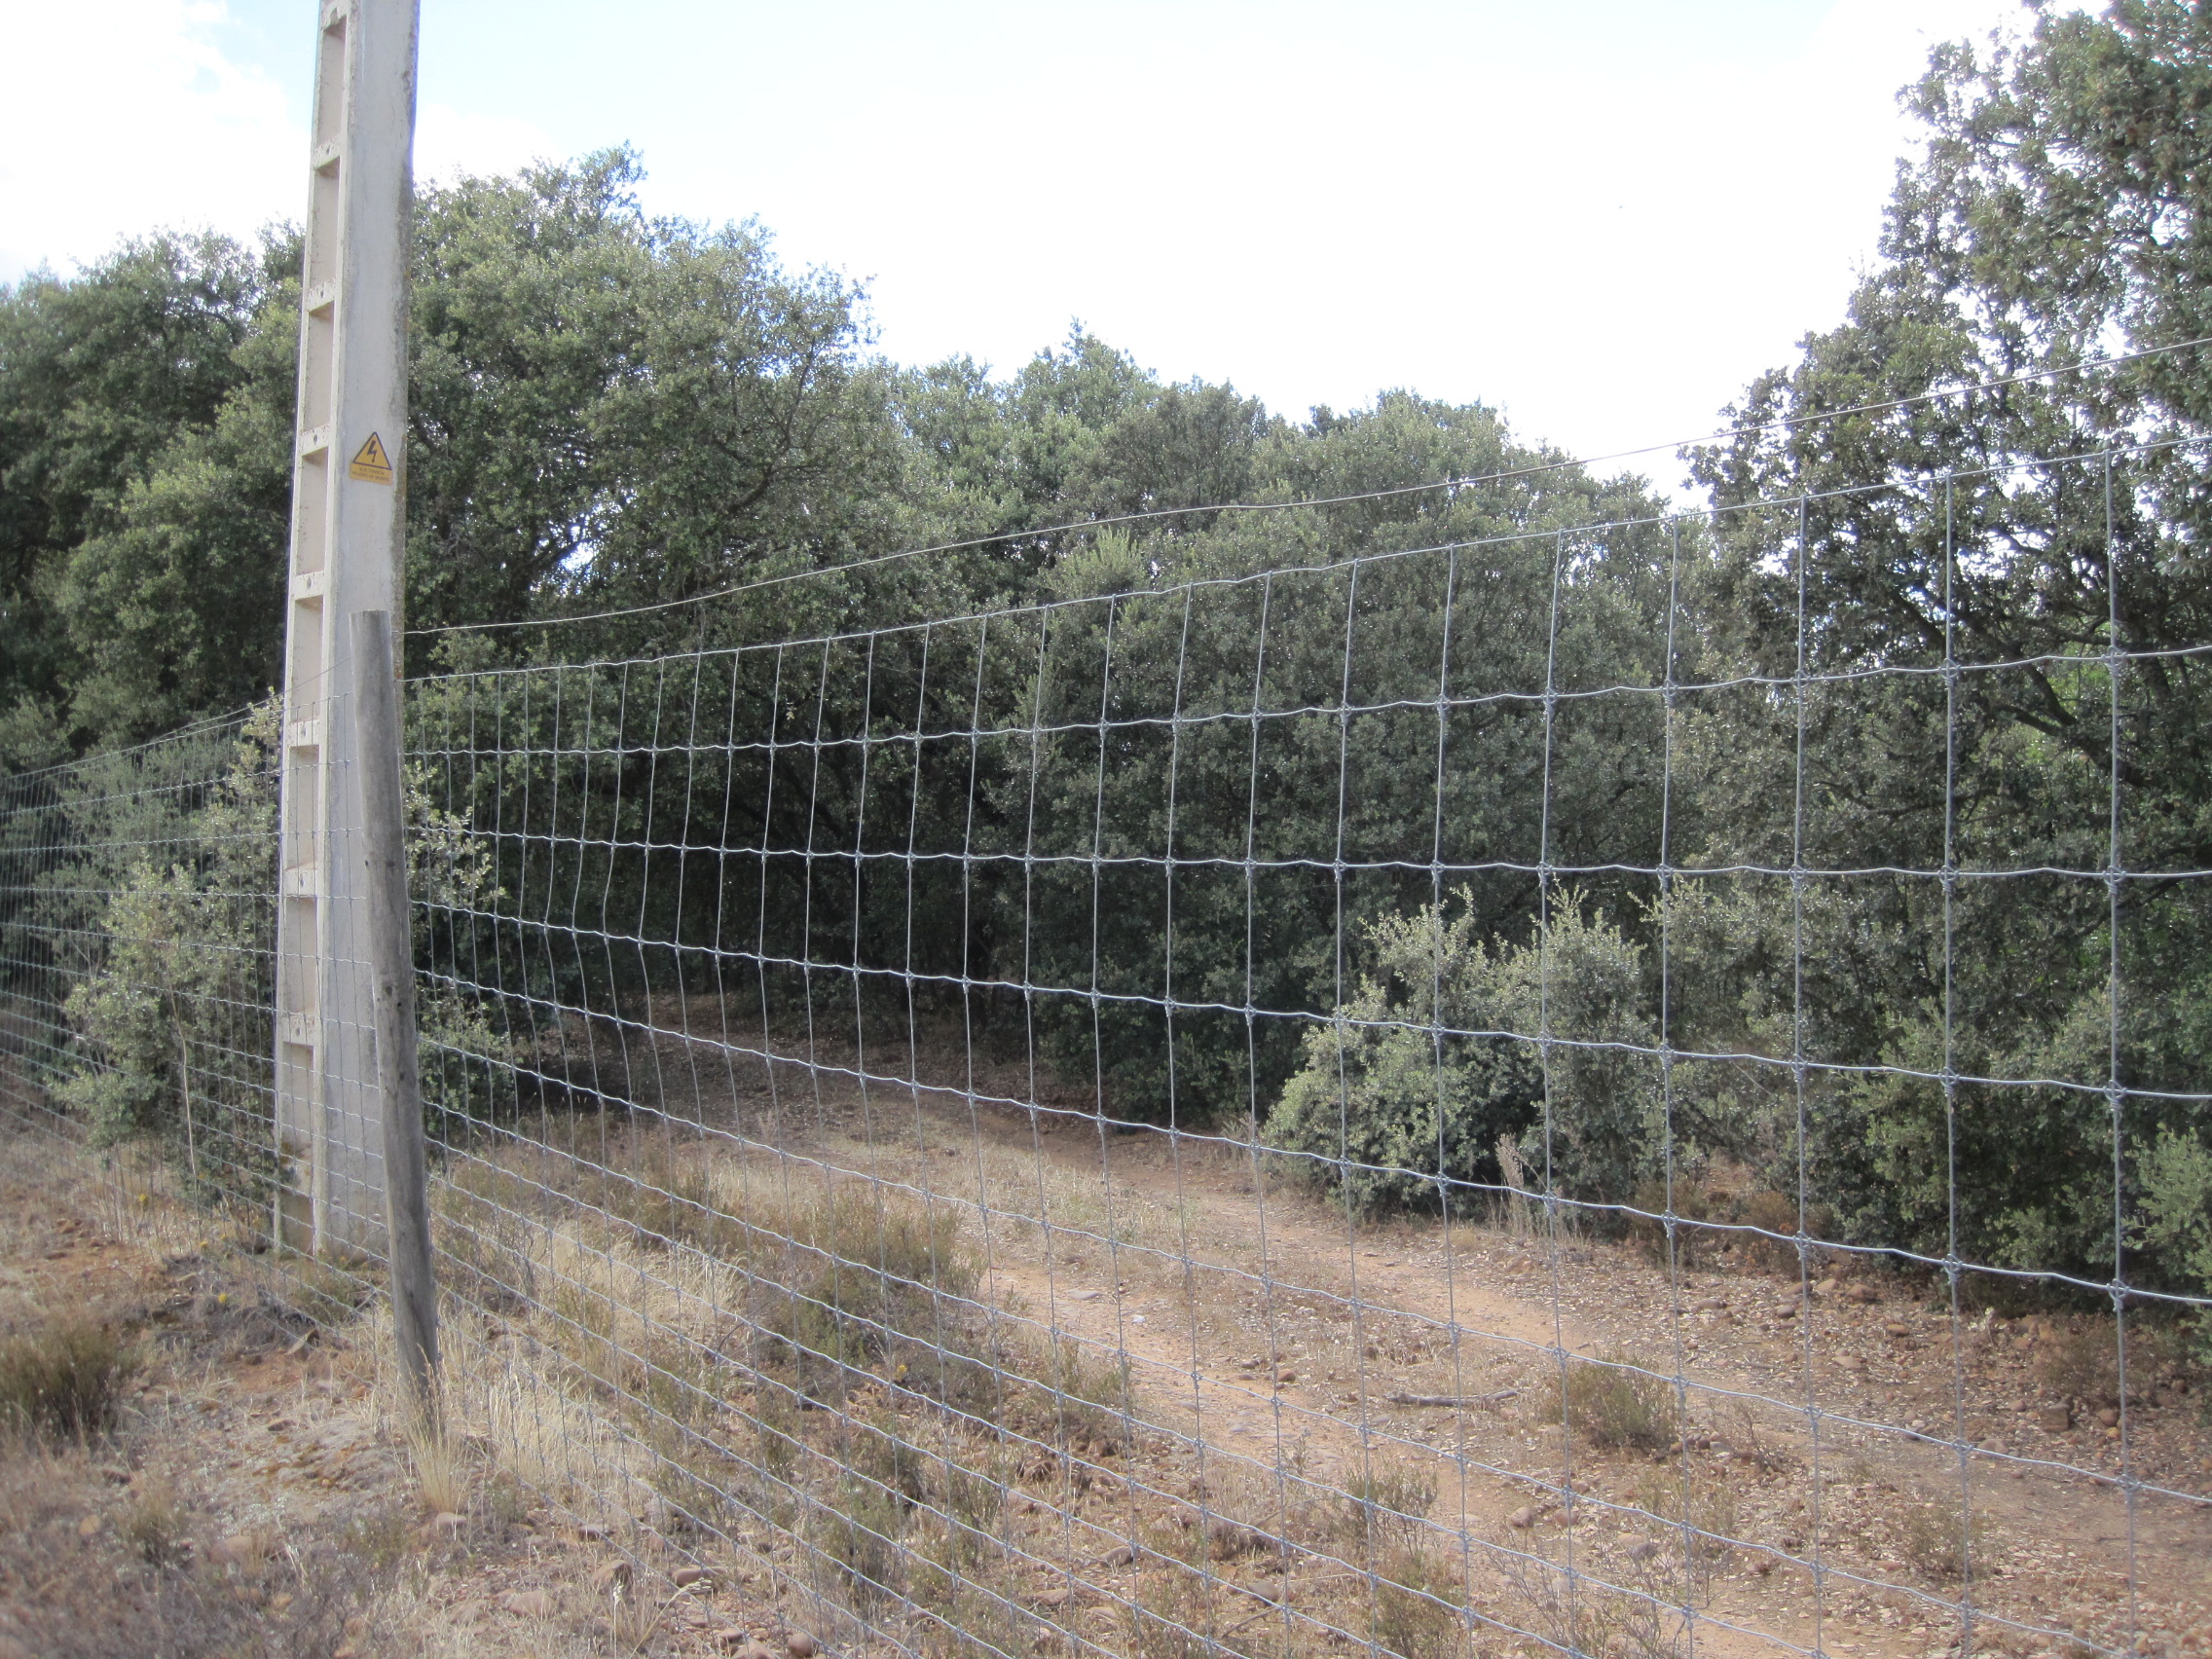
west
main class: Woodland
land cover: Broadleaved woodland
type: broadleaved evergreen forest
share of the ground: > 75 %
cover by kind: broadleaved forest trees 70 %, herbaceous plants 30 %
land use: Forestry
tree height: > 5 m
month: July
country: ES
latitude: 42.1191
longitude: -5.4621
